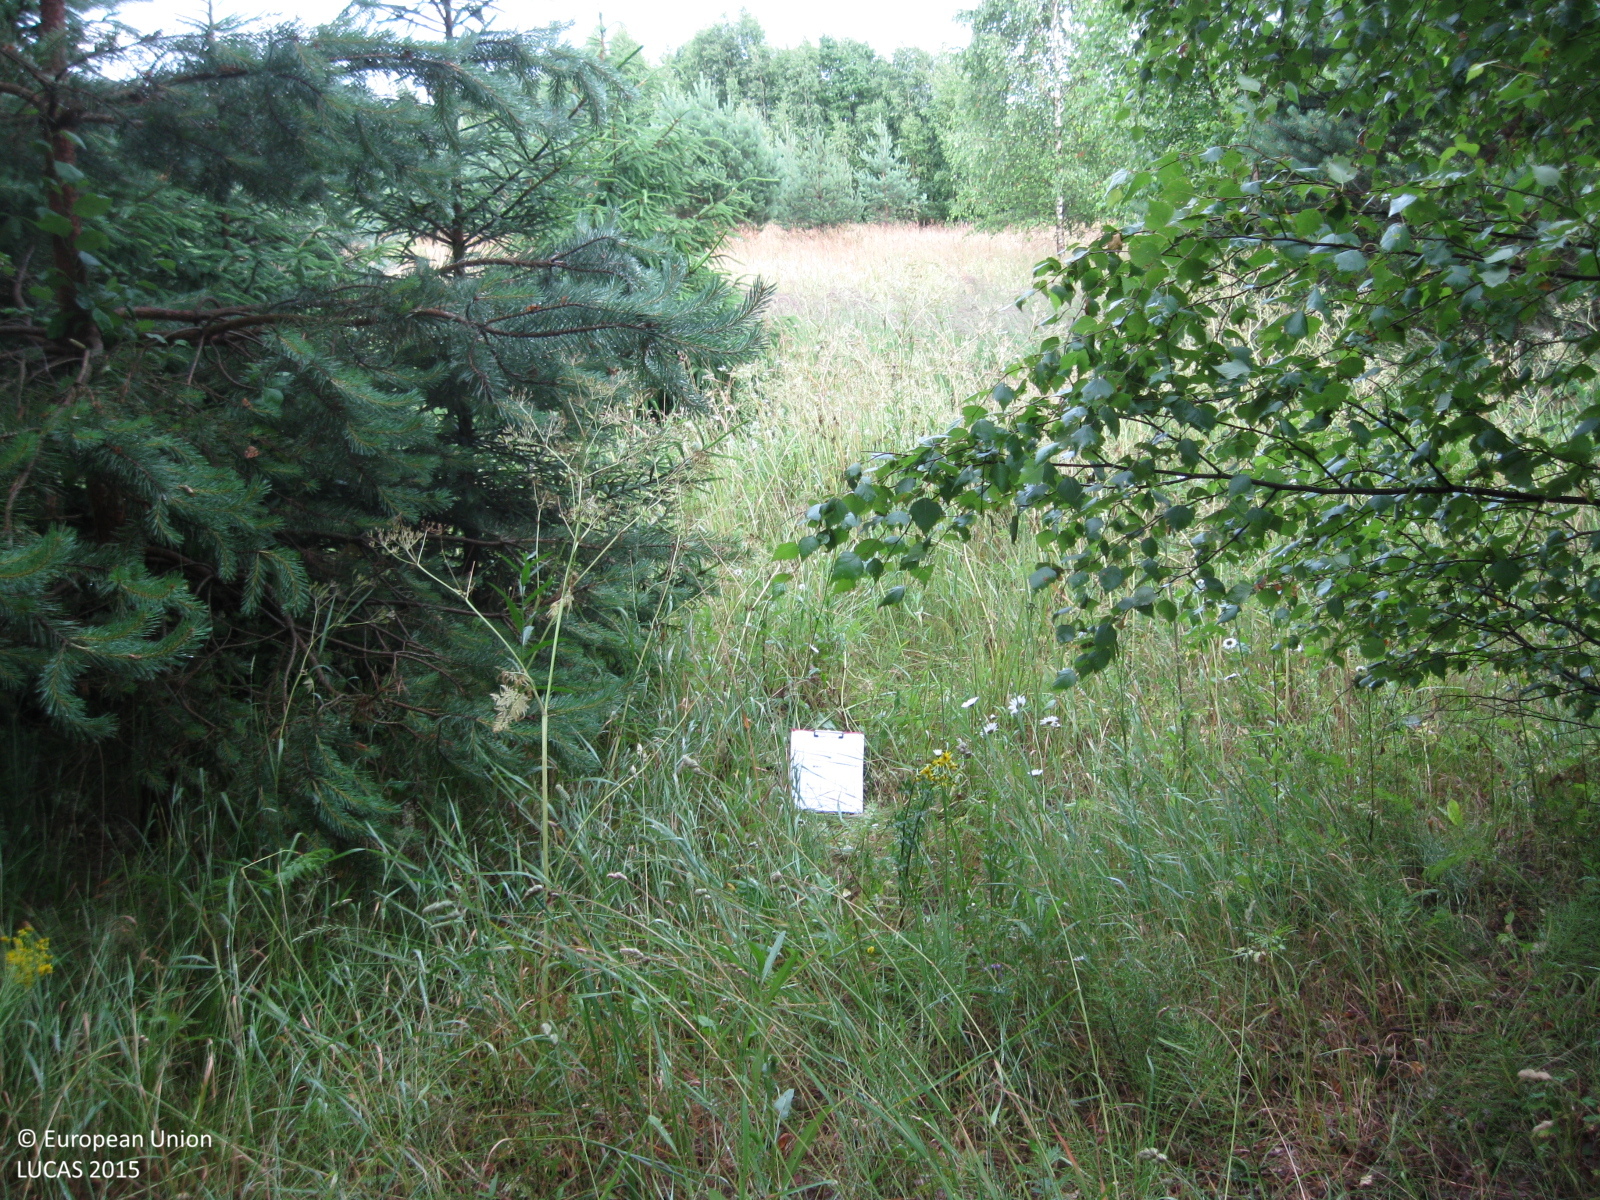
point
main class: Woodland
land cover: Pine dominated mixed woodland
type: hemiboreal forest and nemoral coniferous forest and mixed broadleaved-coniferous forest
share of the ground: 50 - 75 %
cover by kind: herbaceous plants 45 %, coniferous forest trees 35 %, broadleaved forest trees 20 %
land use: Forestry
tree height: > 5 m
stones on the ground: < 10 %
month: July
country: LT
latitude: 55.7503
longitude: 24.7463
